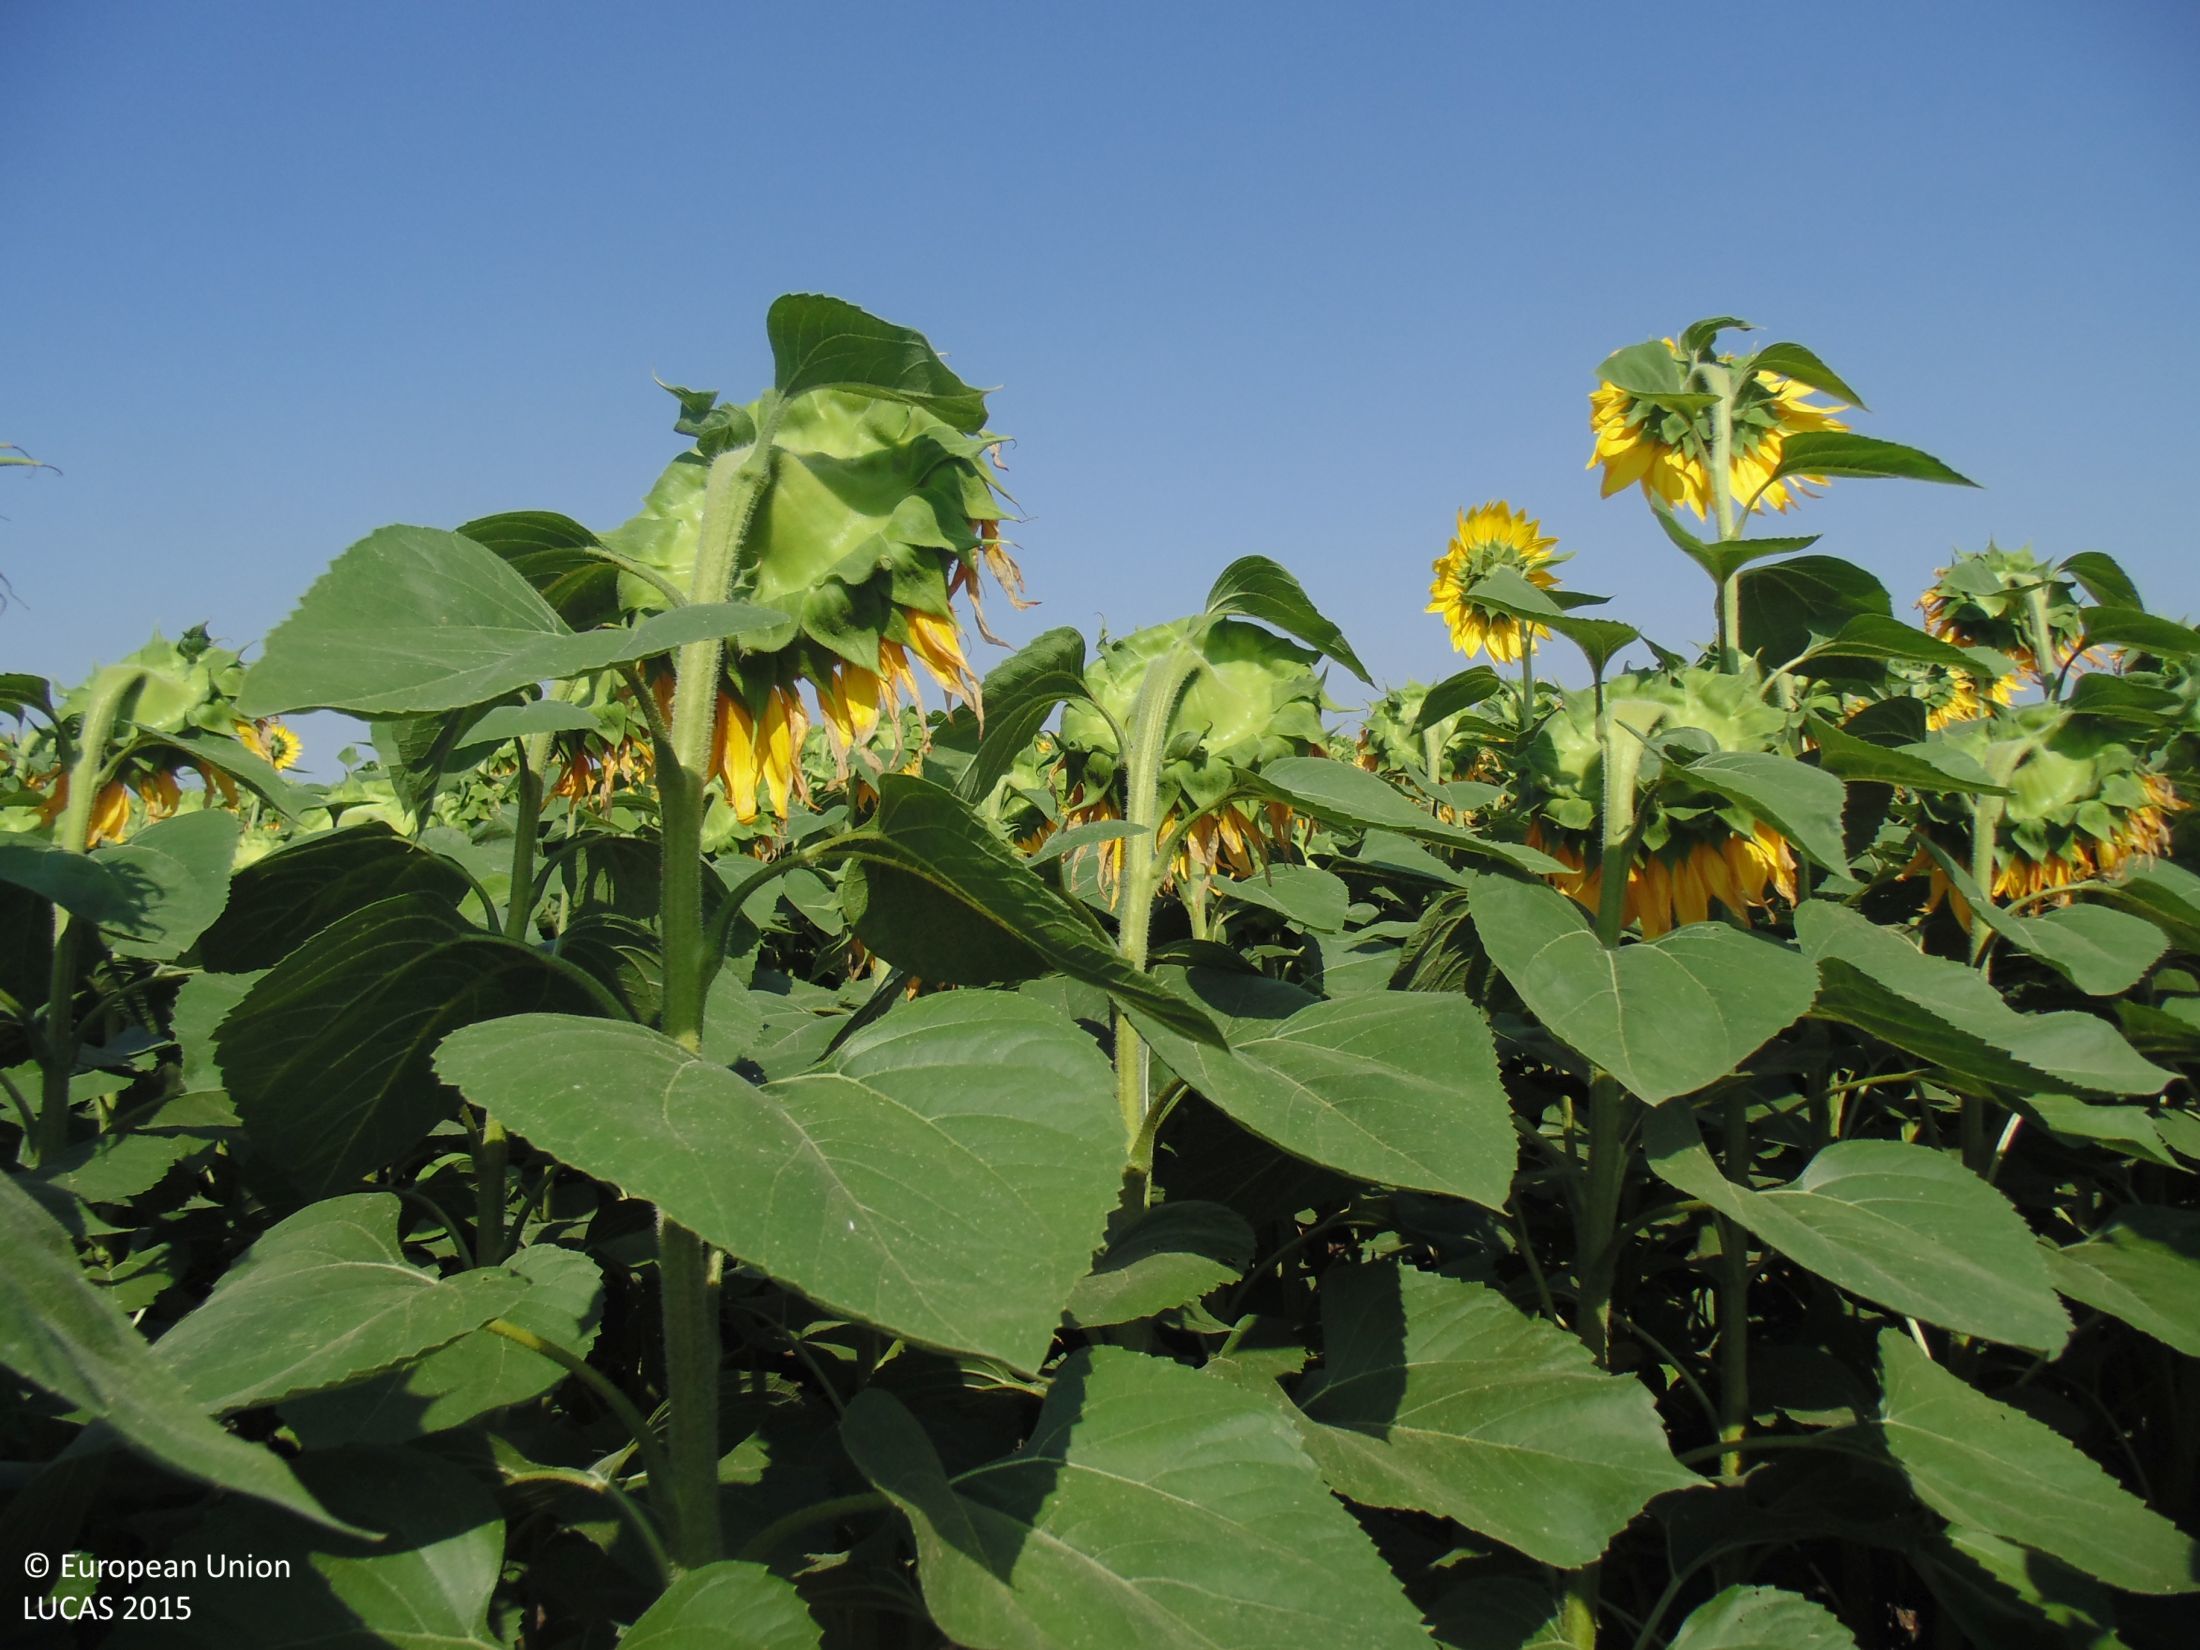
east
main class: Cropland
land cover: Sunflower
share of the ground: > 75 %
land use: Agriculture (excluding fallow land and kitchen gardens)
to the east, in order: Sunflower
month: July
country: BG
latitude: 43.4999
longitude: 27.9915
